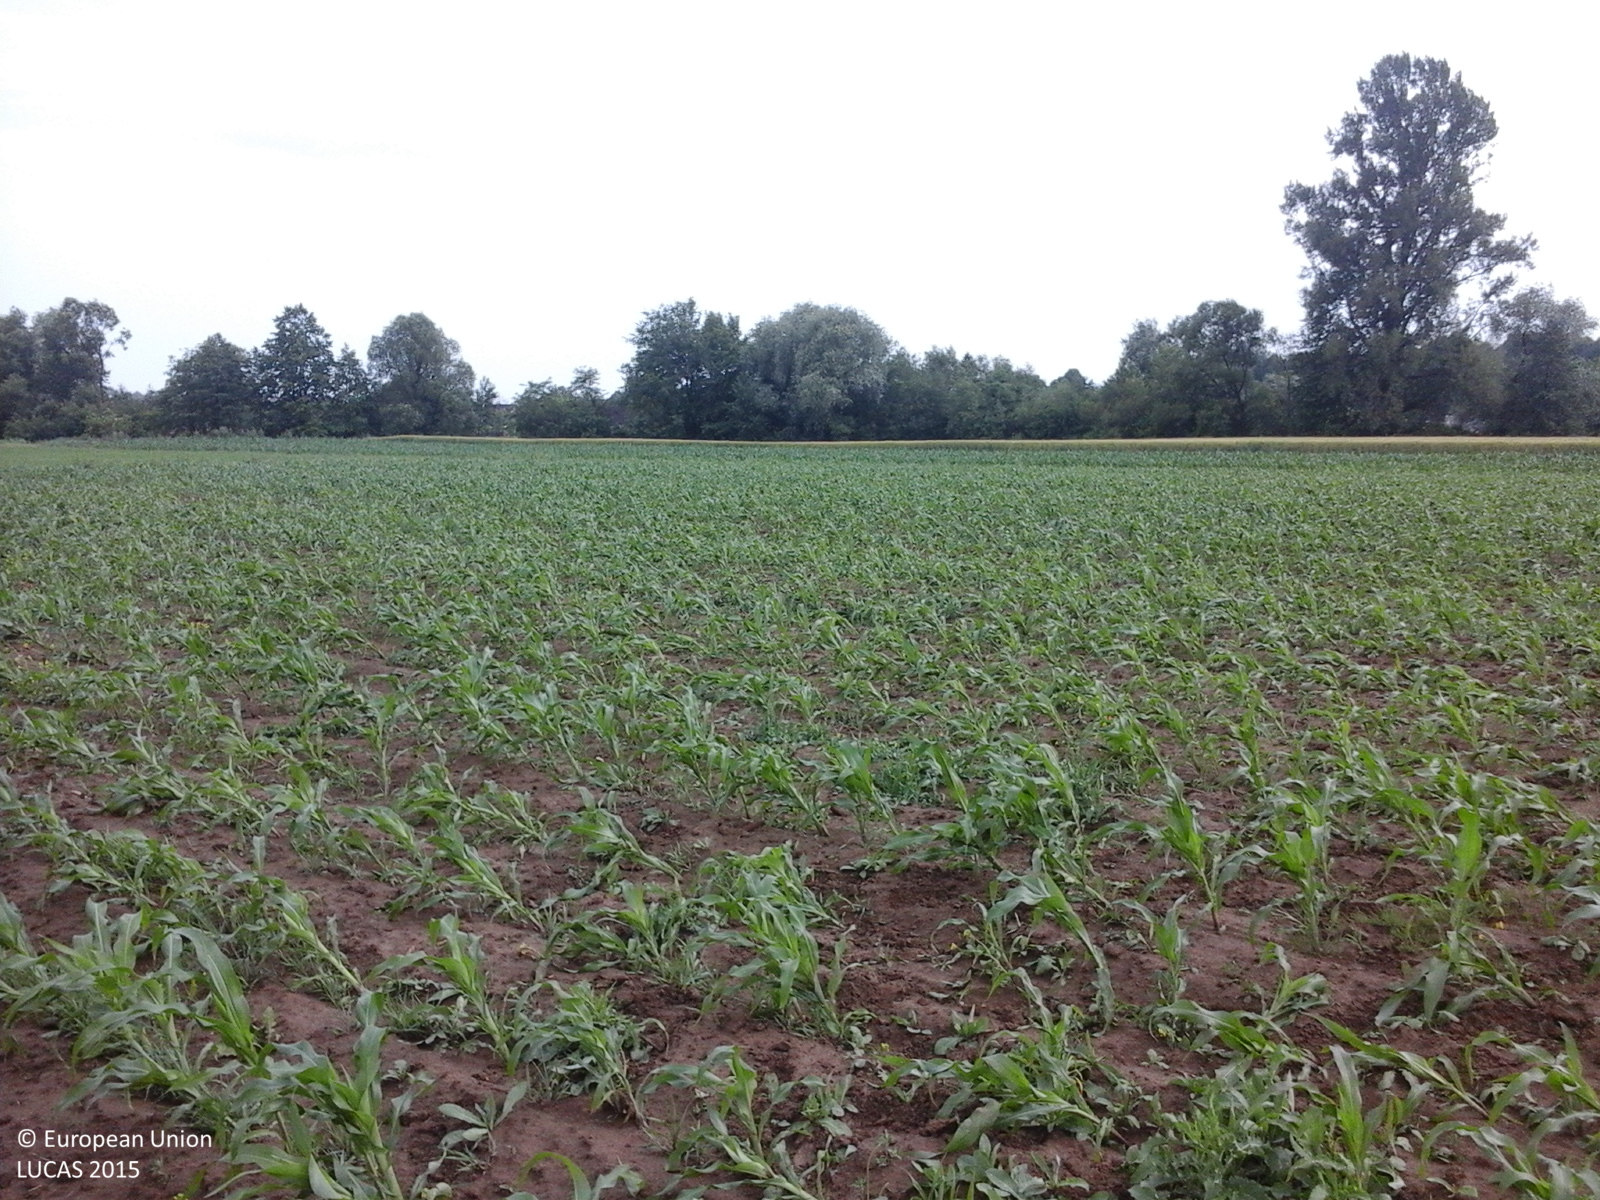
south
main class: Cropland
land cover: Maize
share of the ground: 50 - 75 %
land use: Agriculture (excluding fallow land and kitchen gardens)
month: June
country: RO
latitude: 47.3621
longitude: 26.3297
